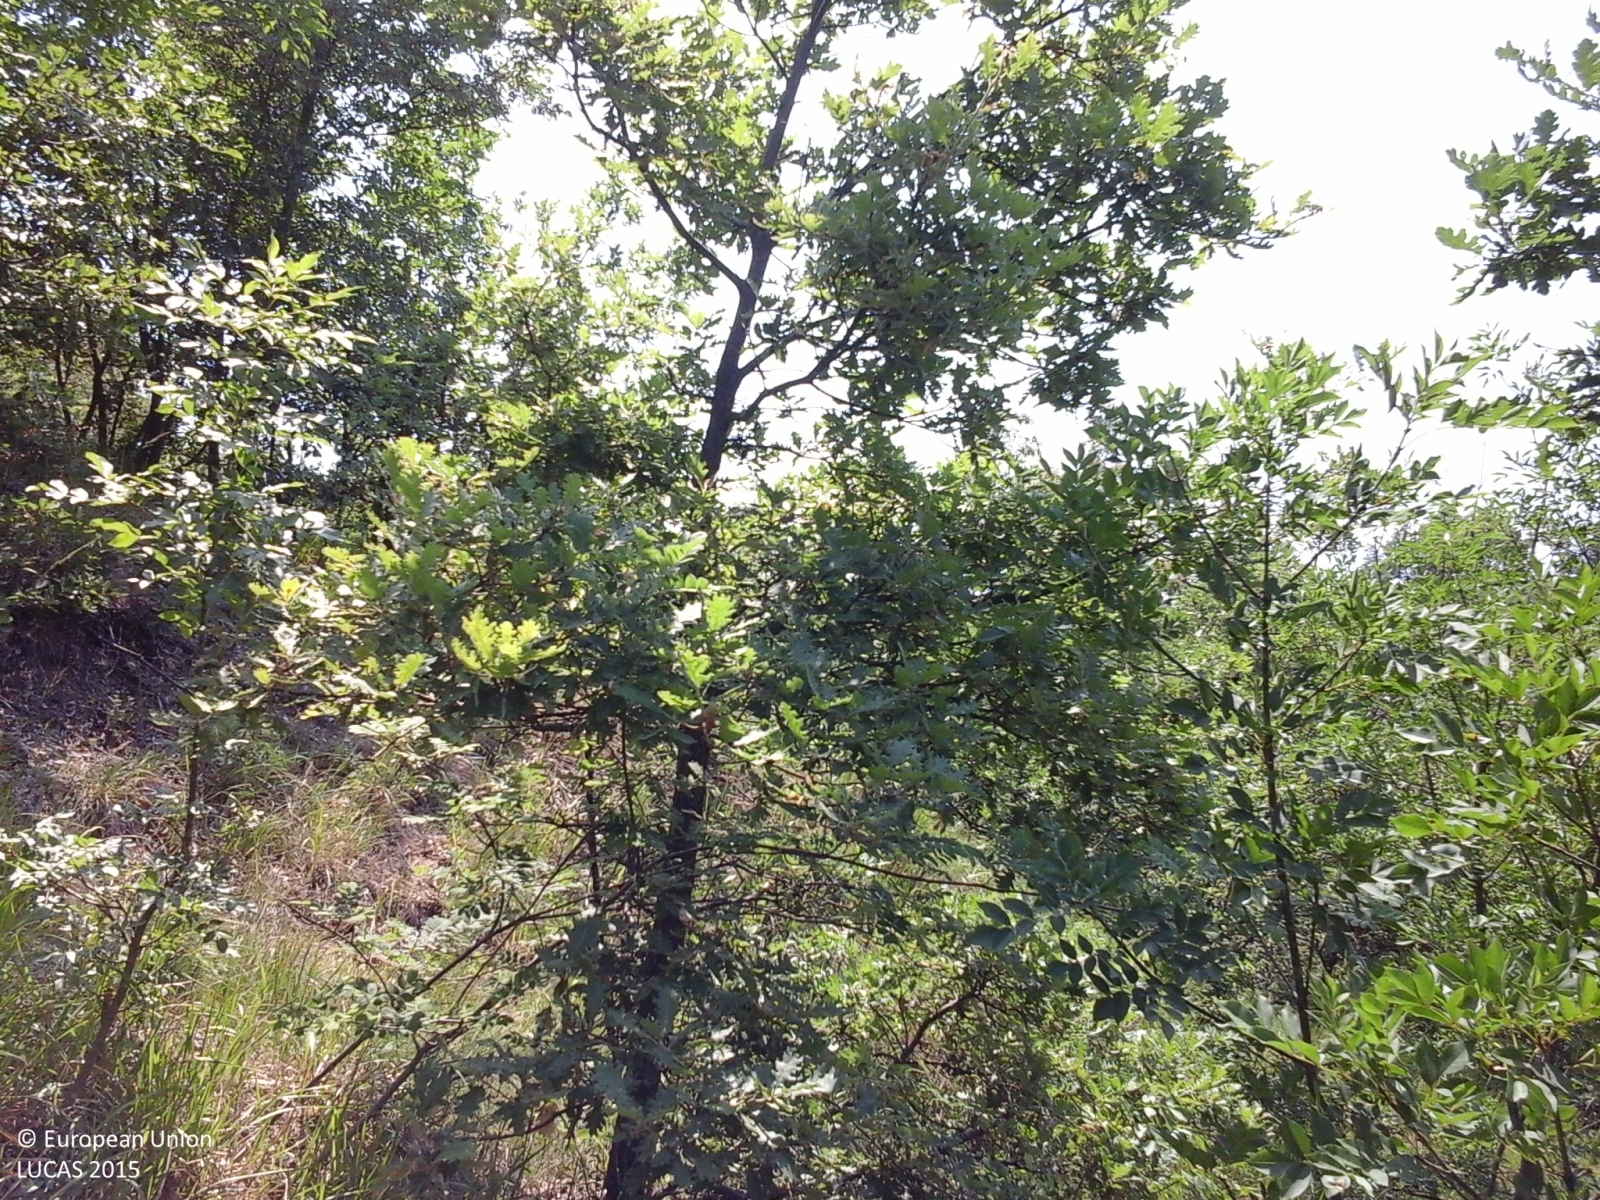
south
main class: Woodland
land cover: Broadleaved woodland
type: thermophilous deciduous forest
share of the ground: 50 - 75 %
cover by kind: broadleaved forest trees 70 %, shrubs 20 %, herbaceous plants 10 %
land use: Forestry
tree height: < 5 m
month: June
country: IT
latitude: 44.5187
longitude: 8.4056
